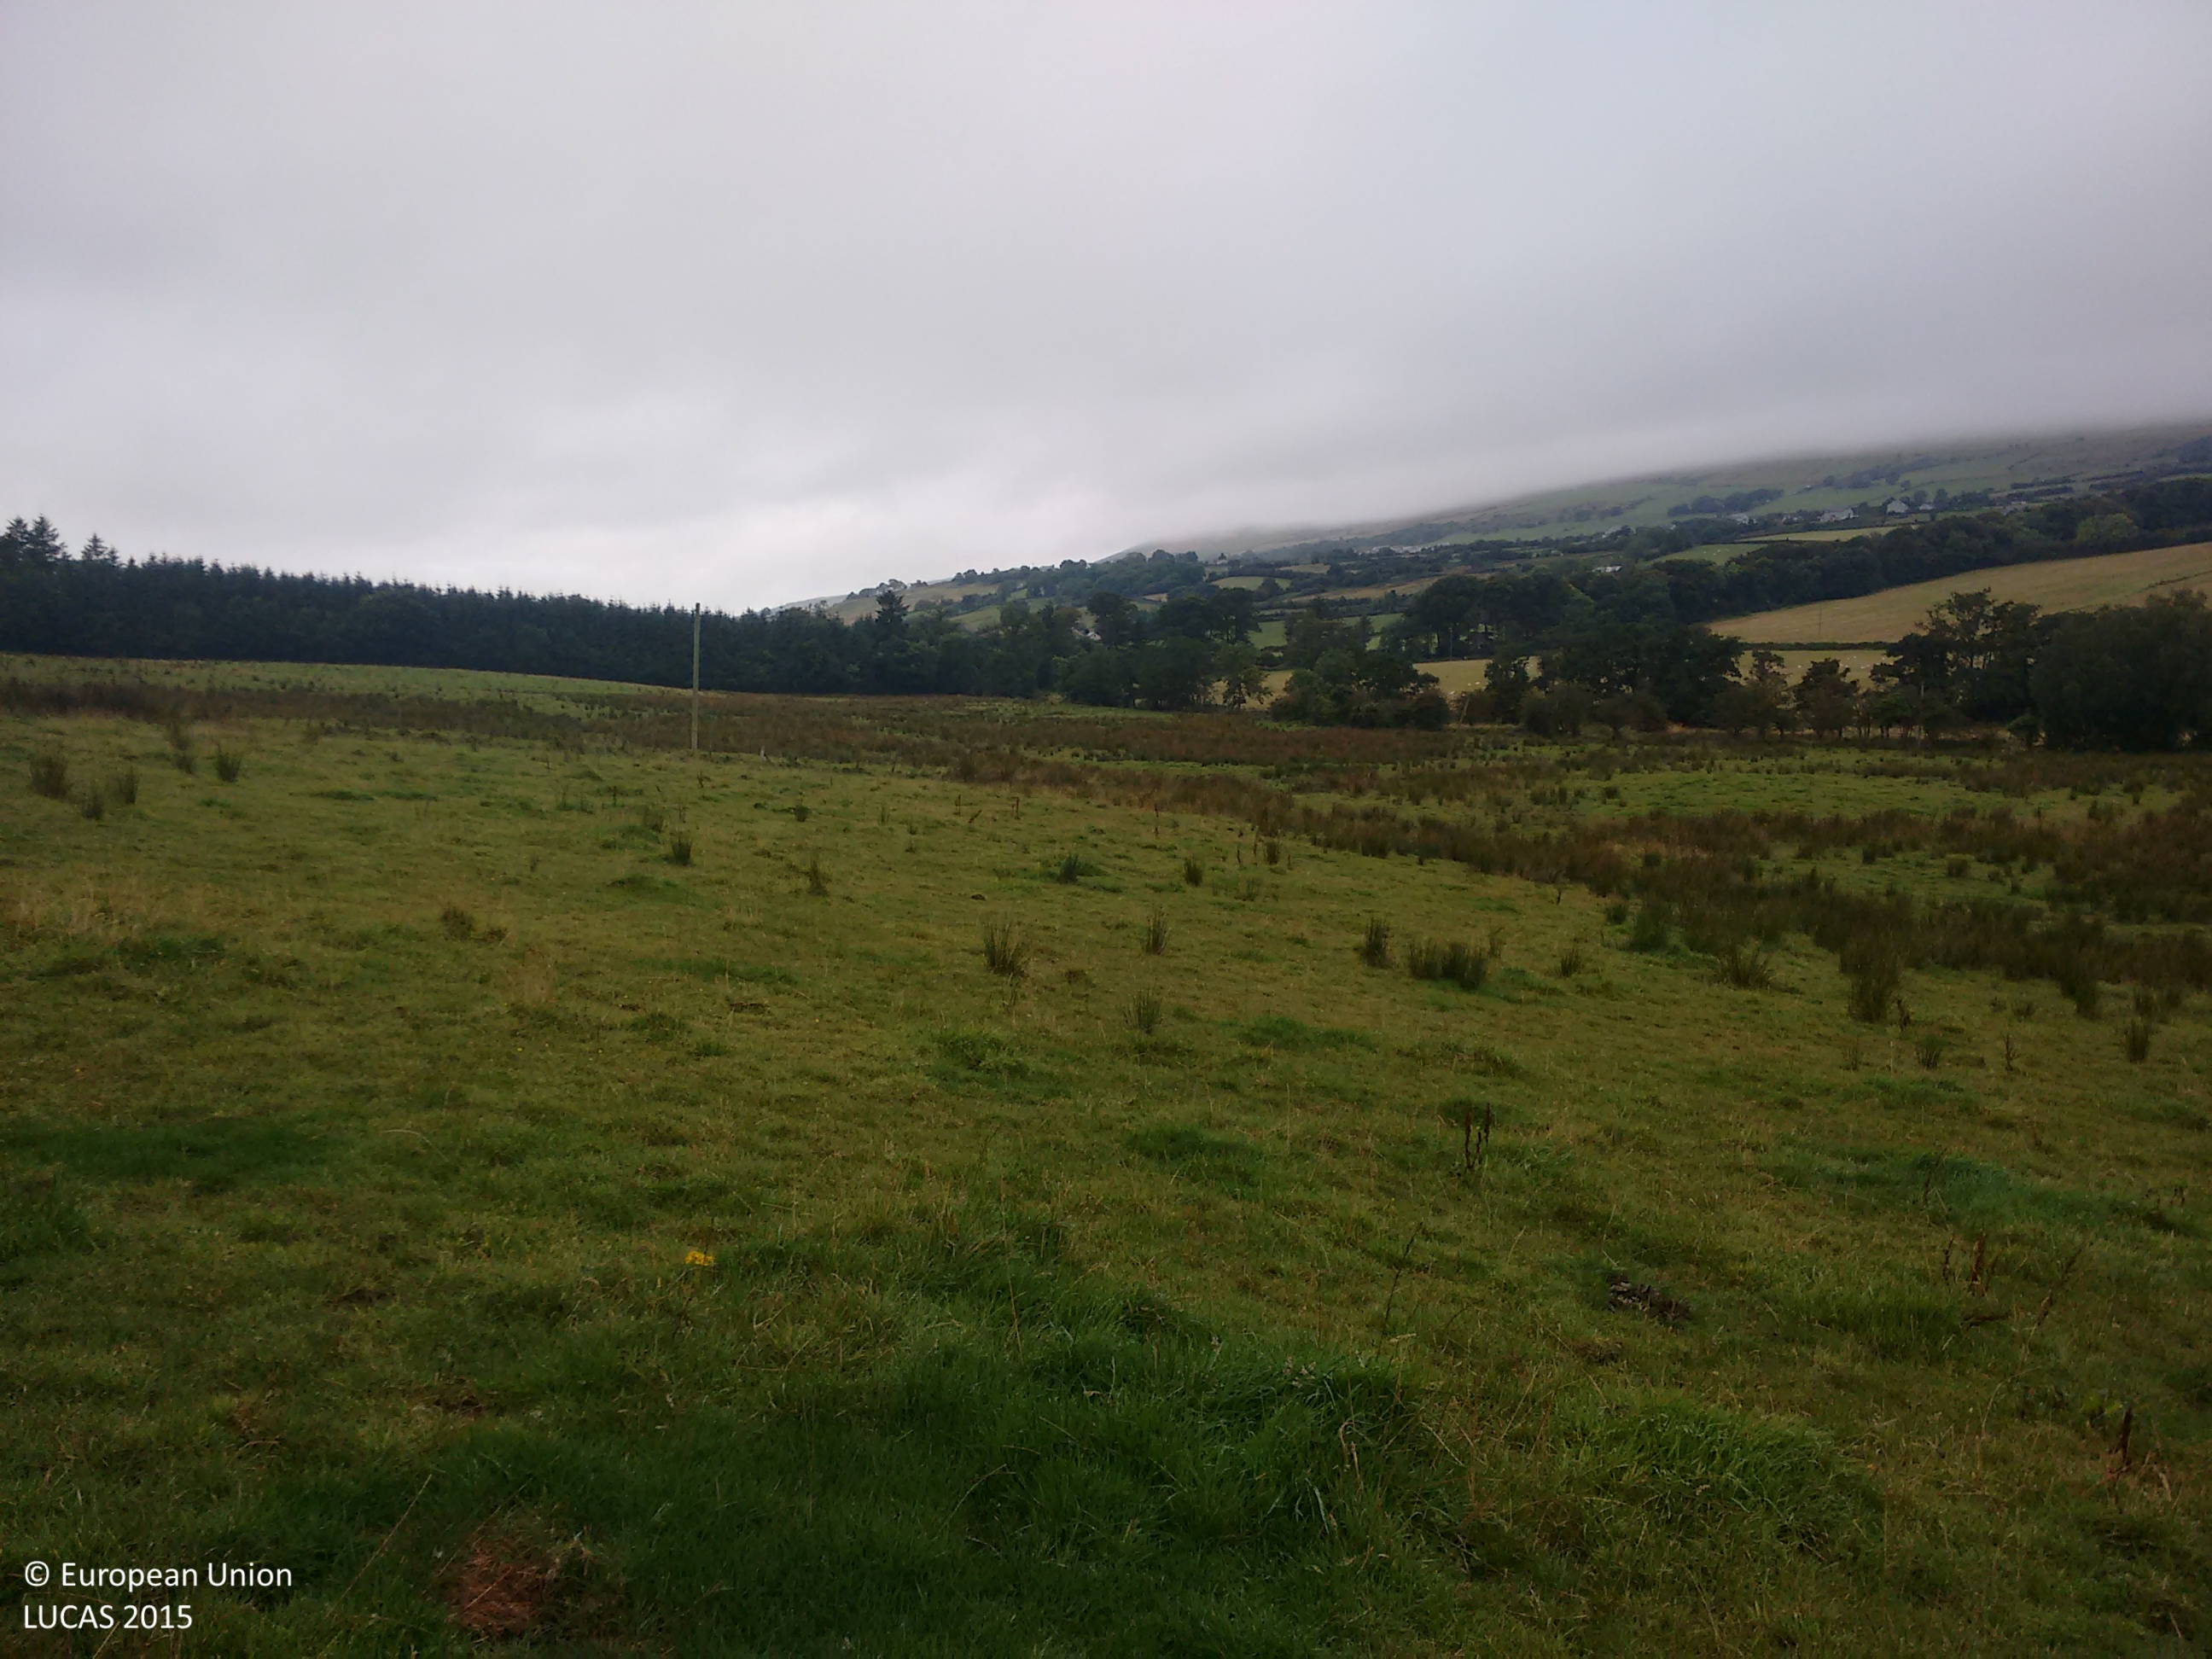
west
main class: Grassland
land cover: Grassland without tree/shrub cover
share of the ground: > 75 %
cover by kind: herbaceous plants 100 %
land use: Agriculture (excluding fallow land and kitchen gardens)
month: September
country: IE
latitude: 55.0644
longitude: -7.3574
